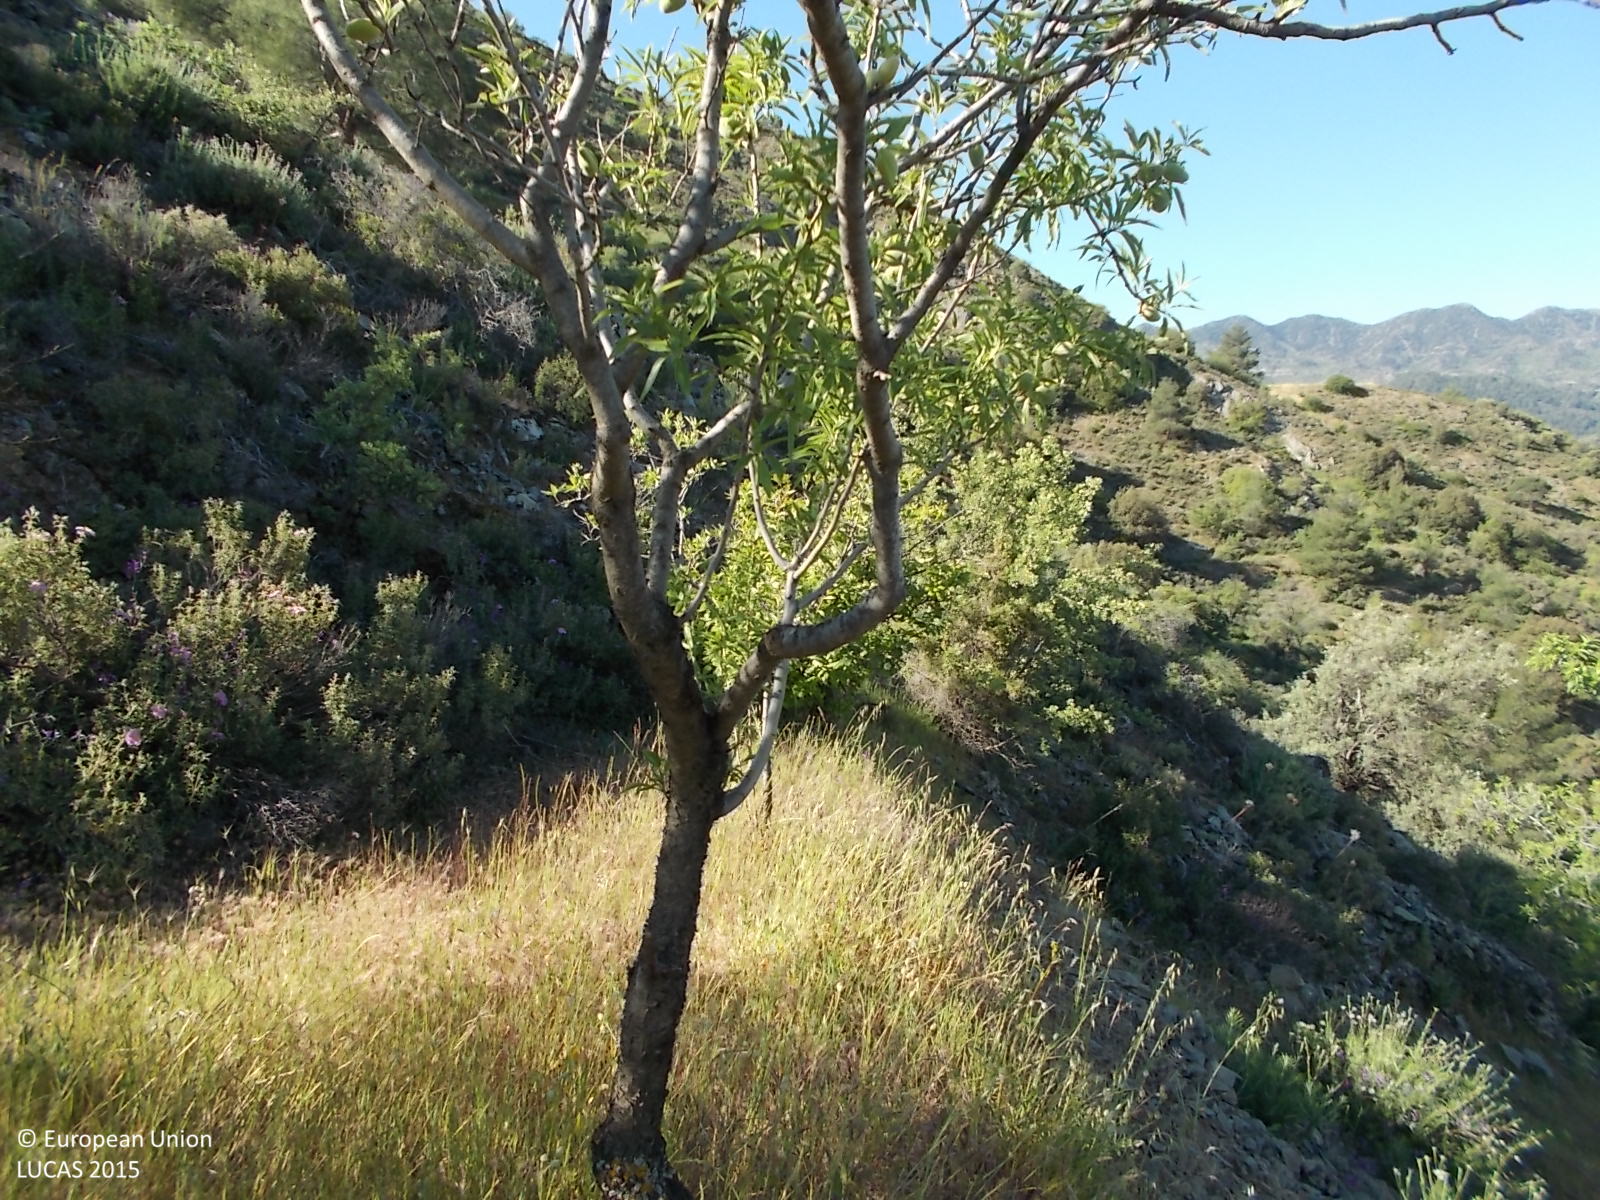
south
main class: Woodland
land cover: Pine dominated coniferous woodland
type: coniferous forest of the mediterranean region
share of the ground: > 75 %
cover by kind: coniferous forest trees 100 %
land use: Semi-natural and natural areas not in use
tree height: > 5 m
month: May
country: CY
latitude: 34.9676
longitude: 33.0545
